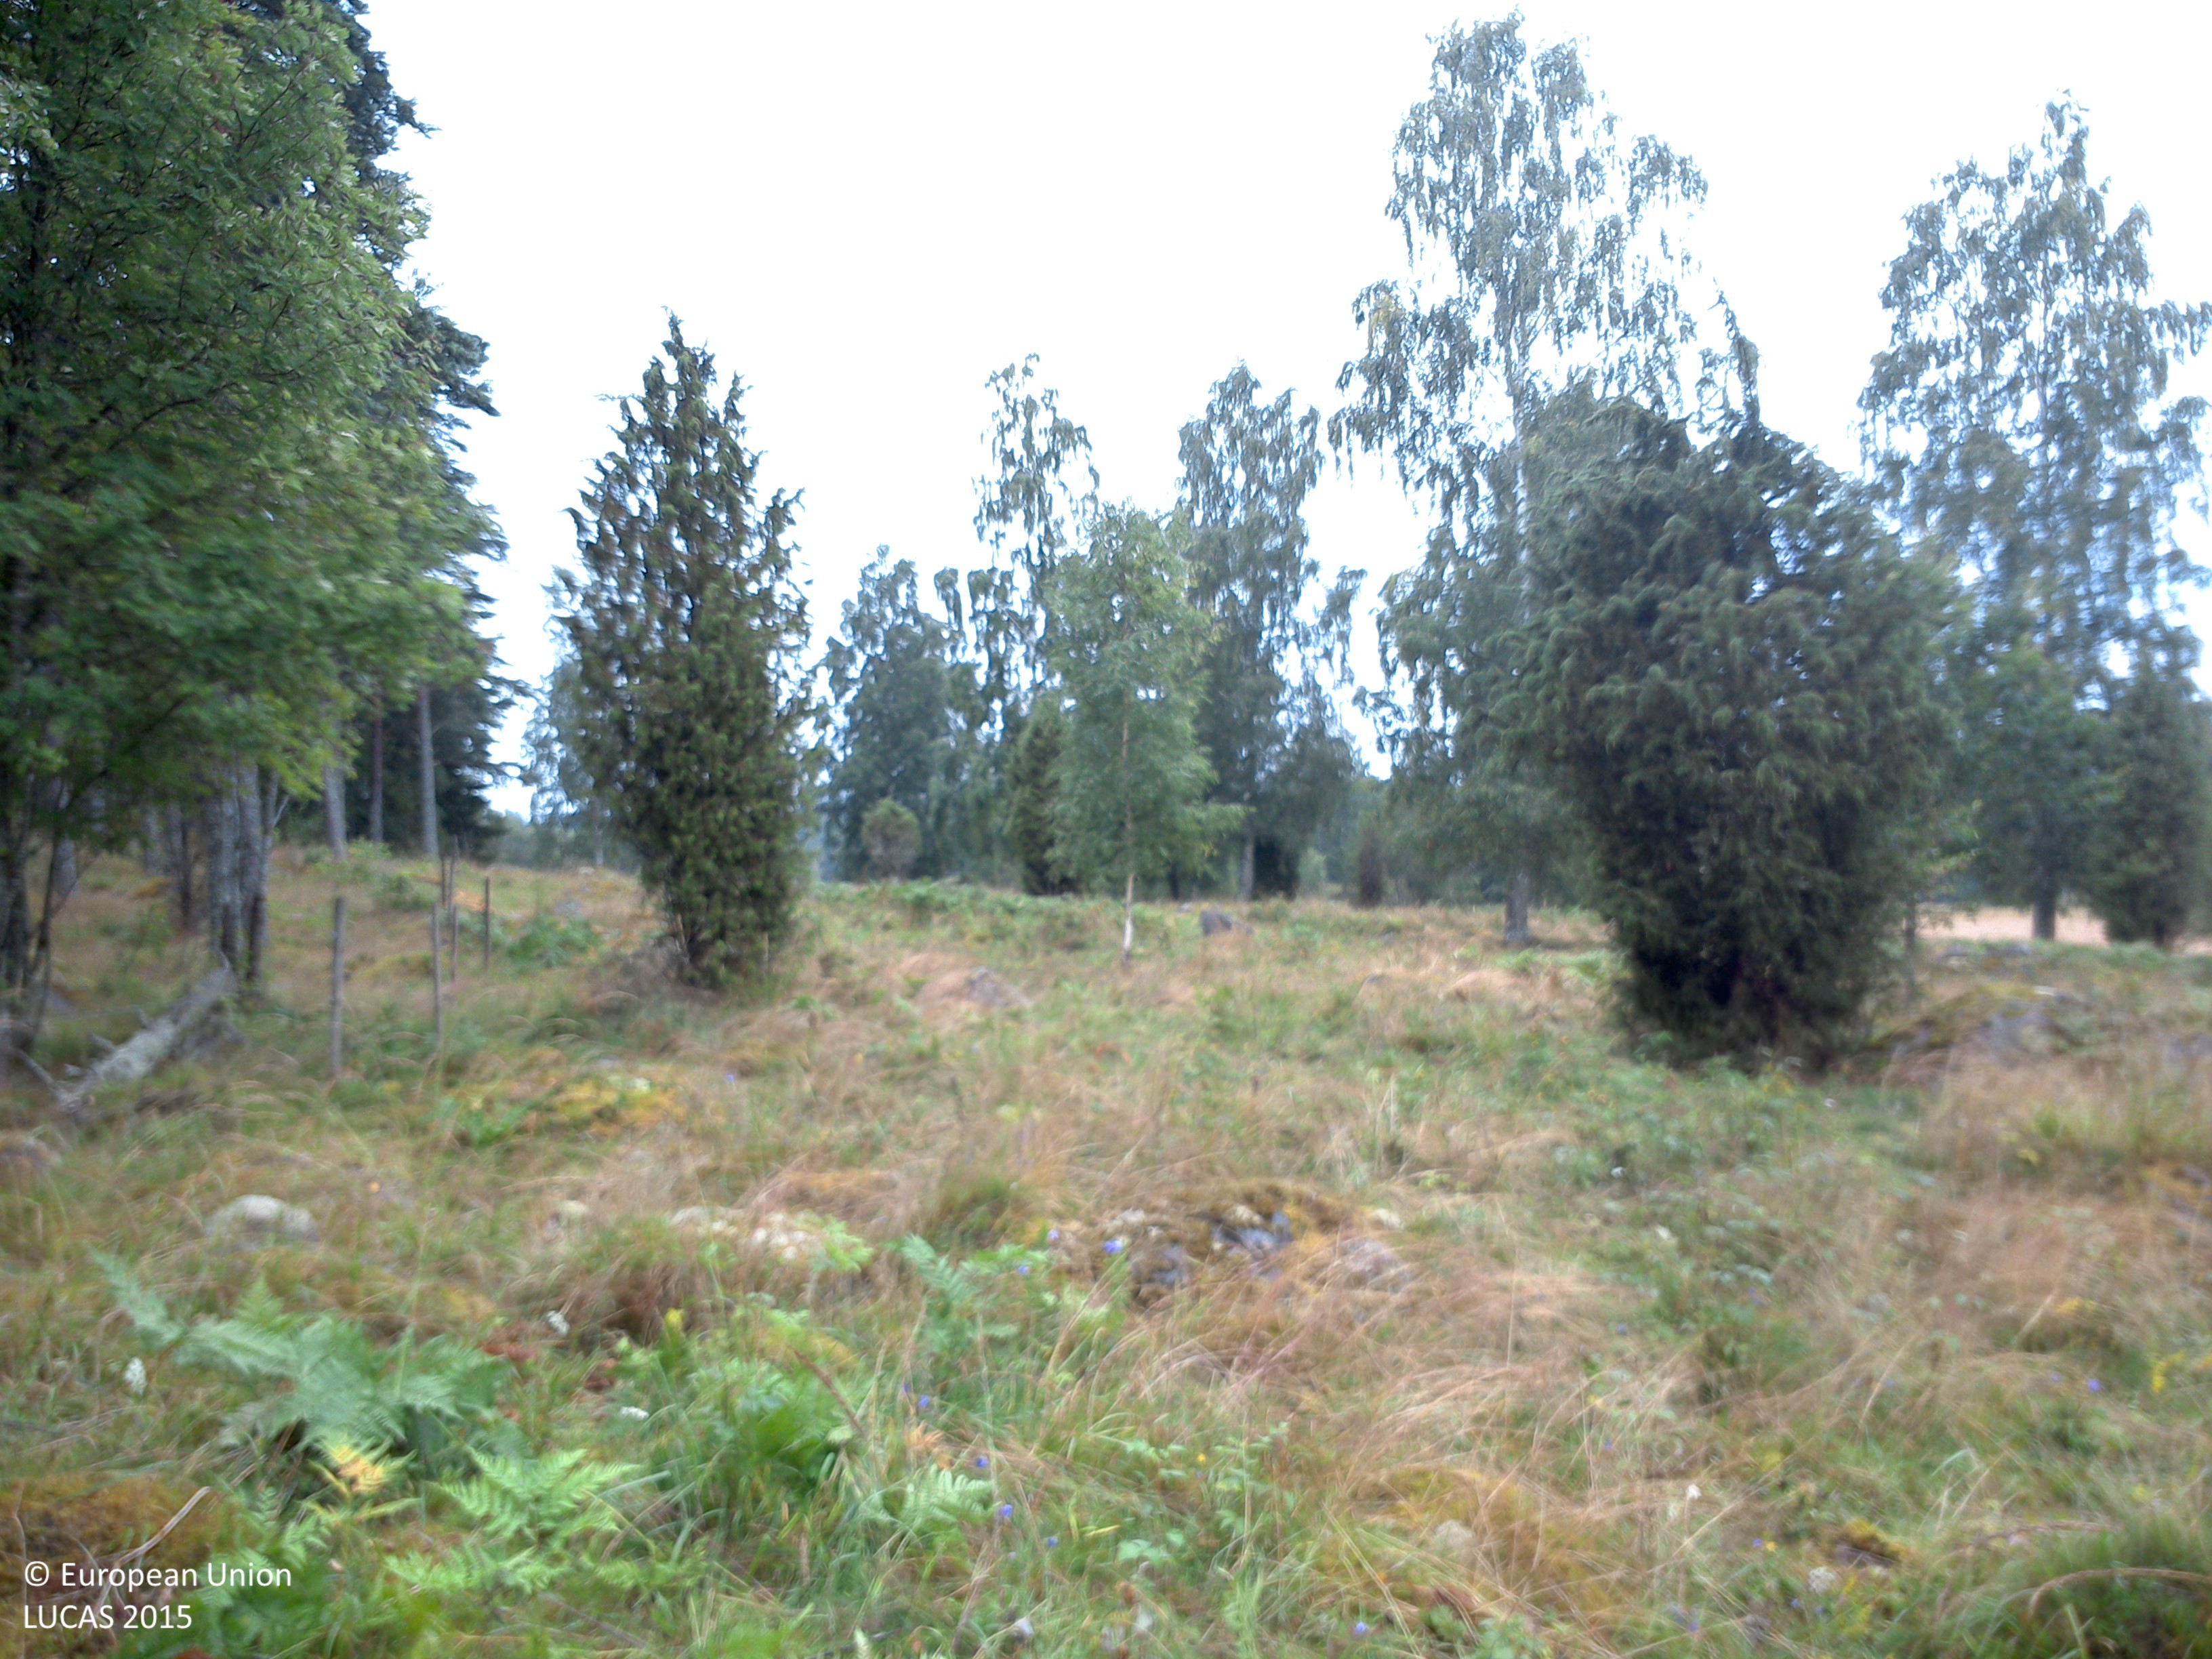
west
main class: Grassland
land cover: Grassland with sparse tree/shrub cover
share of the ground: > 75 %
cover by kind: herbaceous plants 90 %, broadleaved forest trees 5 %, shrubs 5 %
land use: Agriculture (excluding fallow land and kitchen gardens)
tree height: > 5 m
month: August
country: SE
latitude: 58.2141
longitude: 15.5268
